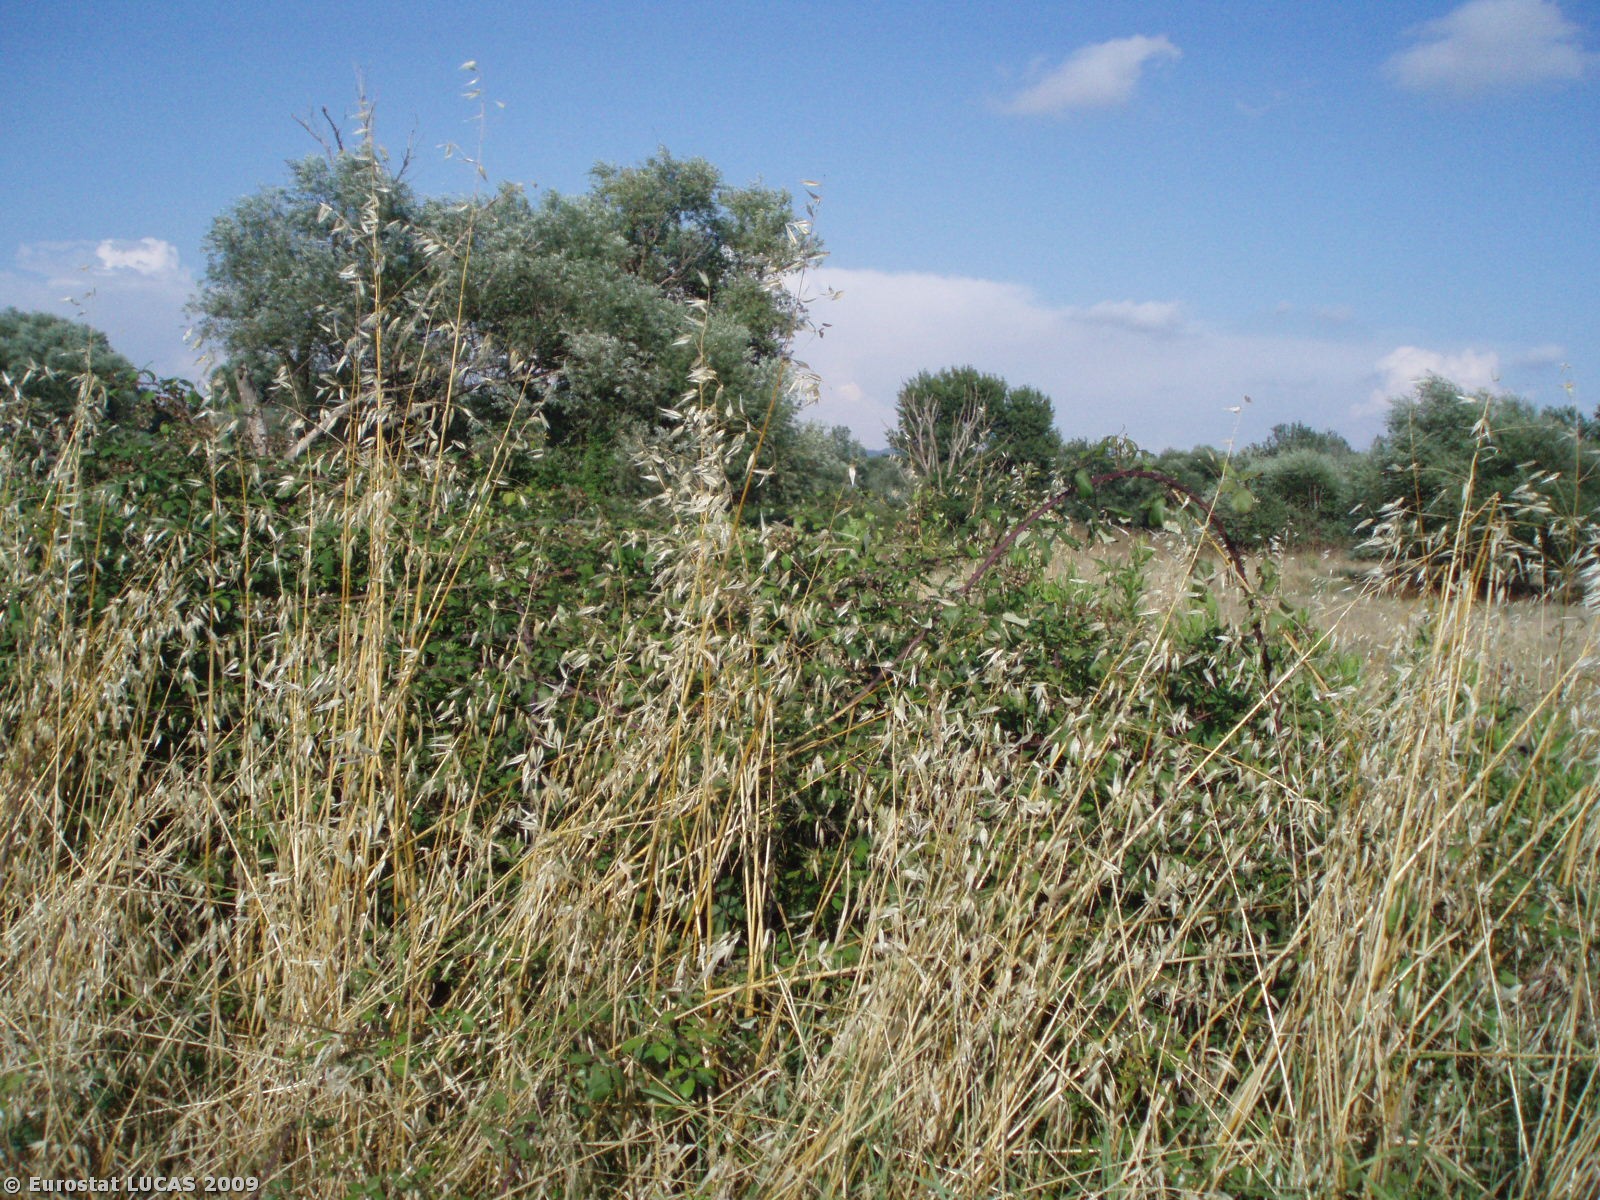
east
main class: Cropland
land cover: Temporary grasslands
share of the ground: > 75 %
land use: Agriculture (excluding fallow land and kitchen gardens)
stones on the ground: < 10 %
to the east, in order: Temporary grasslands; Tracks; Shruby margins; Grassland with sparse tree/shrub cover
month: June
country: IT
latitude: 42.4605
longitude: 11.6118
